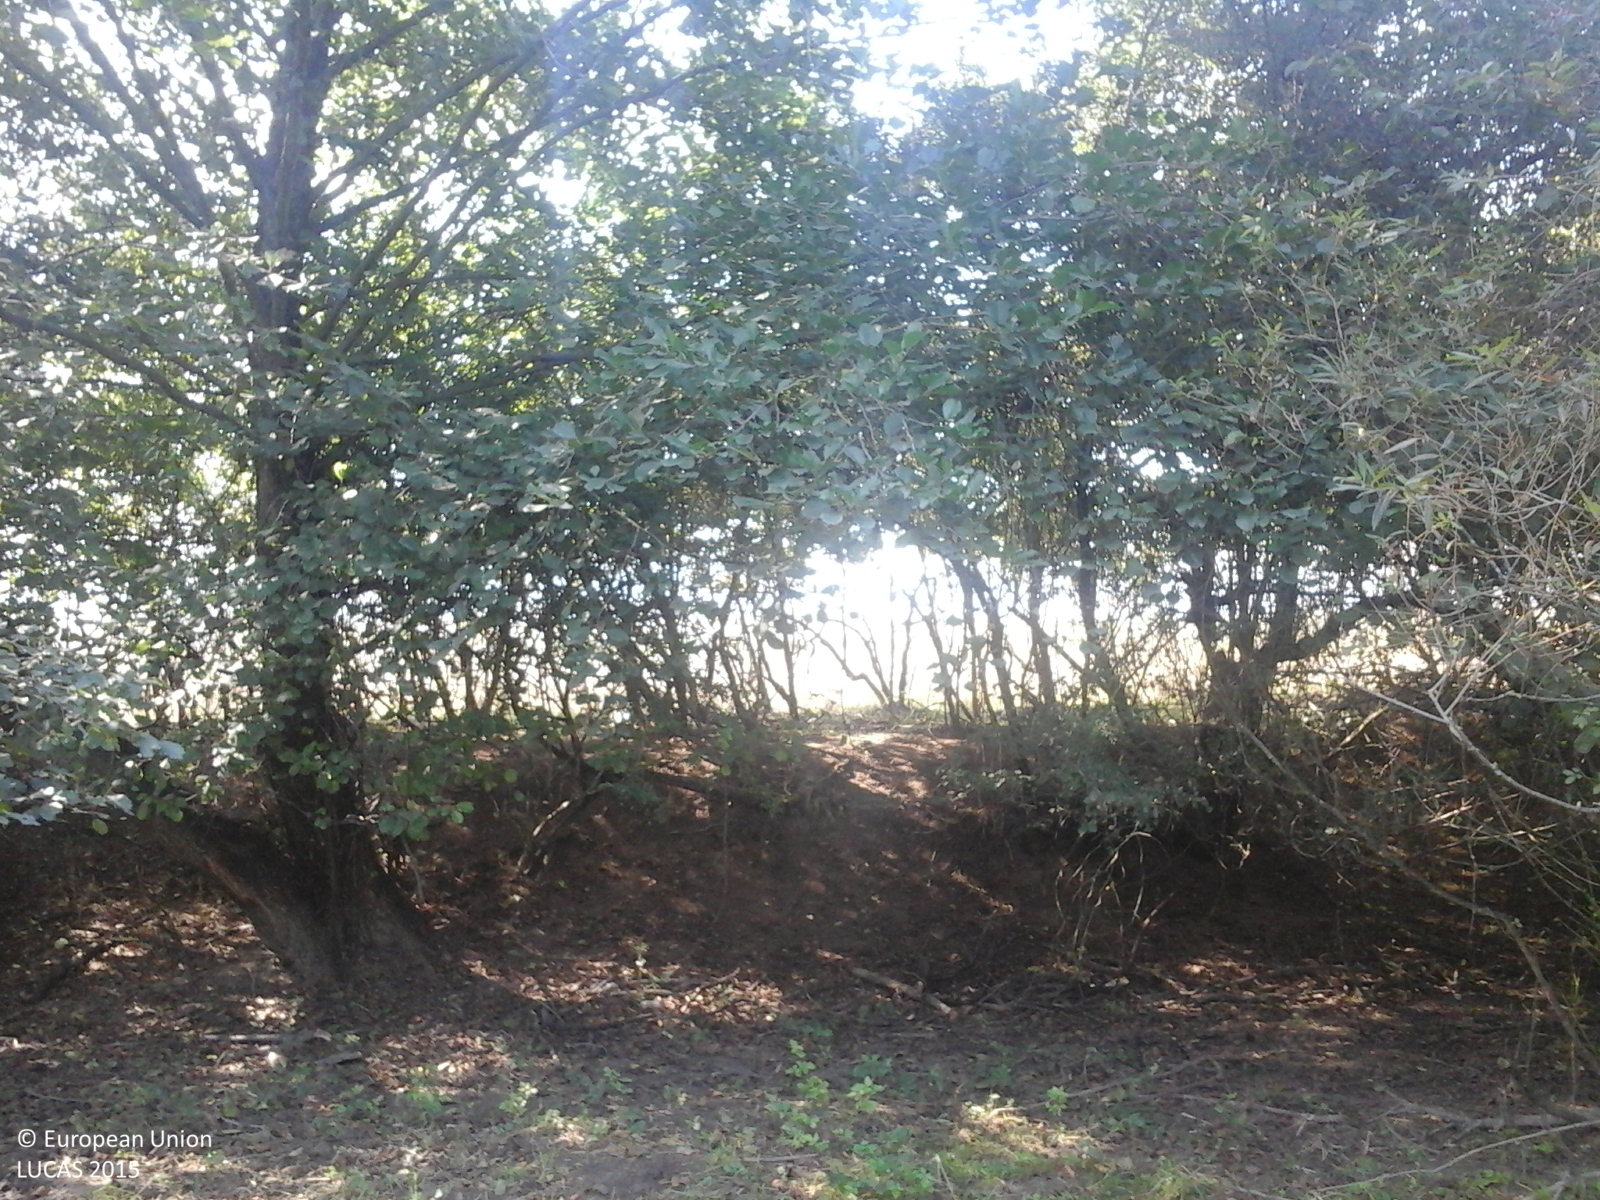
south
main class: Grassland
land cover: Grassland without tree/shrub cover
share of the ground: > 75 %
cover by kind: herbaceous plants 100 %
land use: Agriculture (excluding fallow land and kitchen gardens)
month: September
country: RO
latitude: 47.1390
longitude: 22.7029
